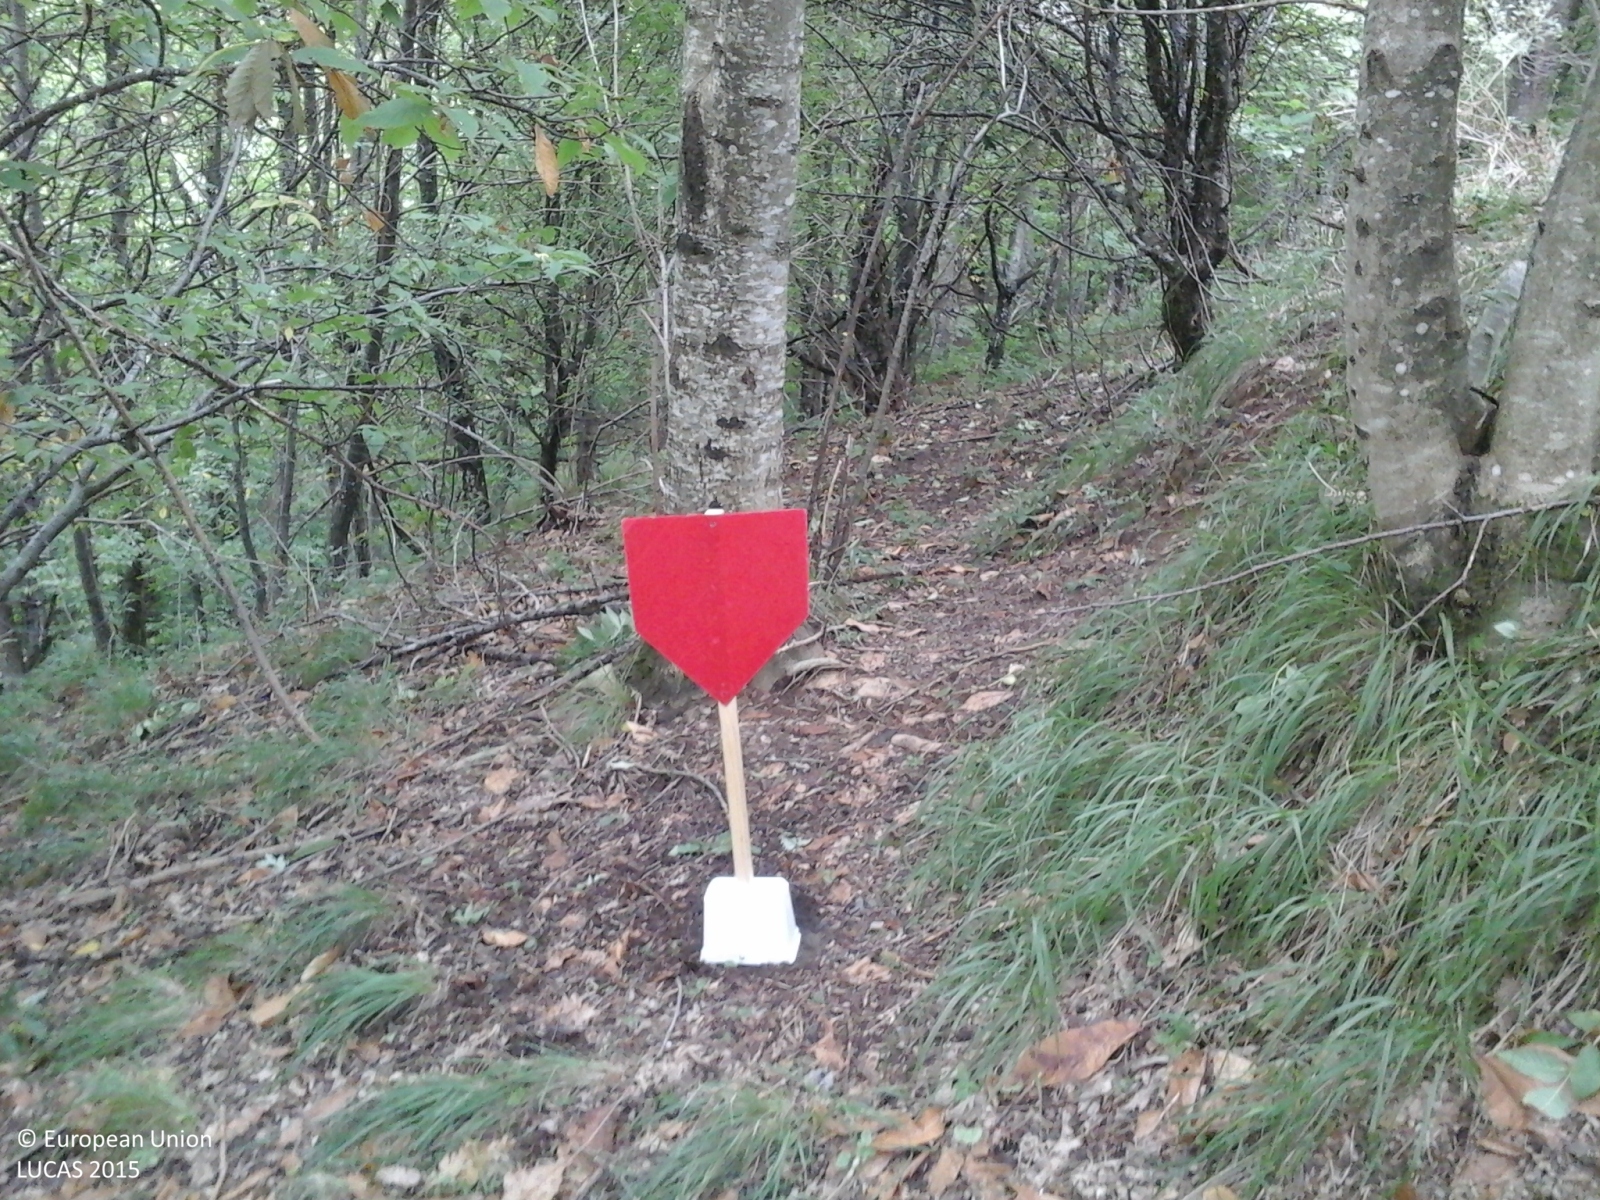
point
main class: Woodland
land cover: Broadleaved woodland
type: thermophilous deciduous forest
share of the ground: > 75 %
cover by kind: broadleaved forest trees 90 %, herbaceous plants 10 %
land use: Forestry
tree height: > 5 m
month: September
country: IT
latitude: 44.5102
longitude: 9.2595
